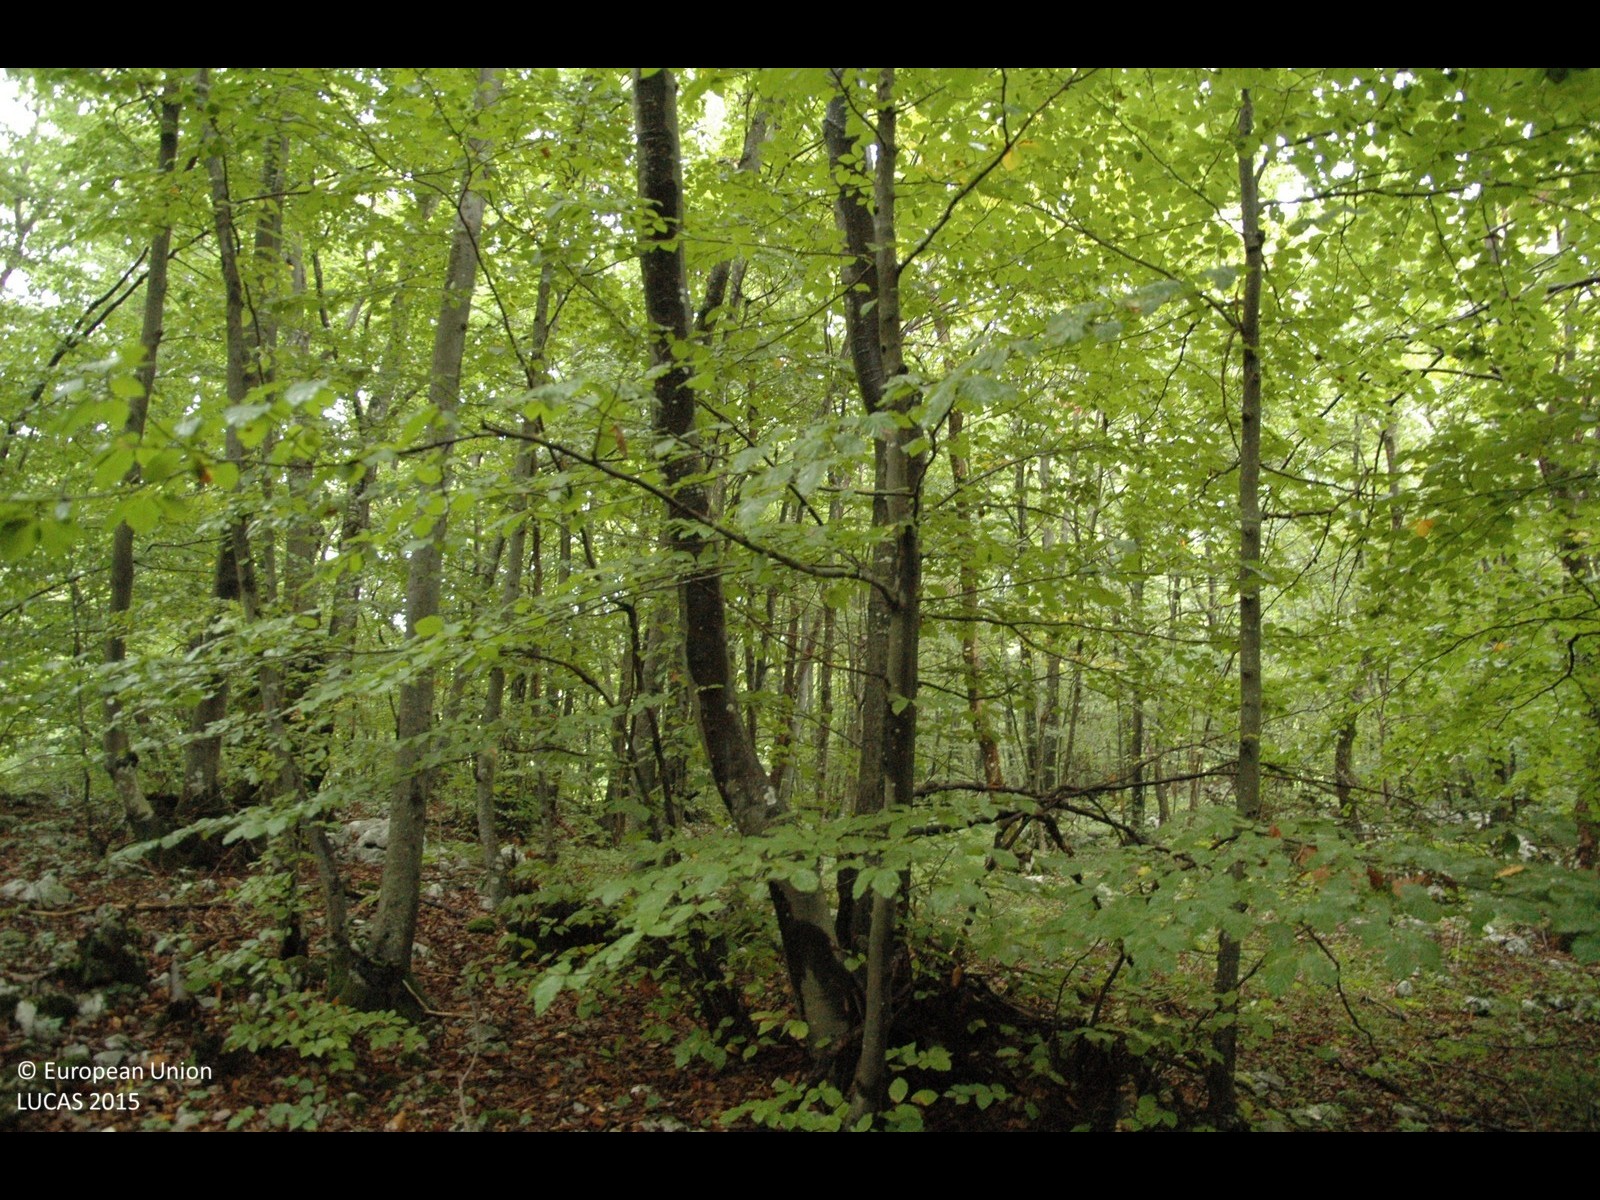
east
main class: Woodland
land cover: Broadleaved woodland
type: beech forest
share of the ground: > 75 %
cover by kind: broadleaved forest trees 100 %
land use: Forestry
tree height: > 5 m
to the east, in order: Broadleaved woodland; Grassland without tree/shrub cover; Single bushes/trees; Grassland without tree/shrub cover; Abandoned hedges; Paved roads, cycling and walking lanes; Grassland with sparse tree/shrub cover
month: October
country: HR
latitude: 45.1392
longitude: 15.2469
